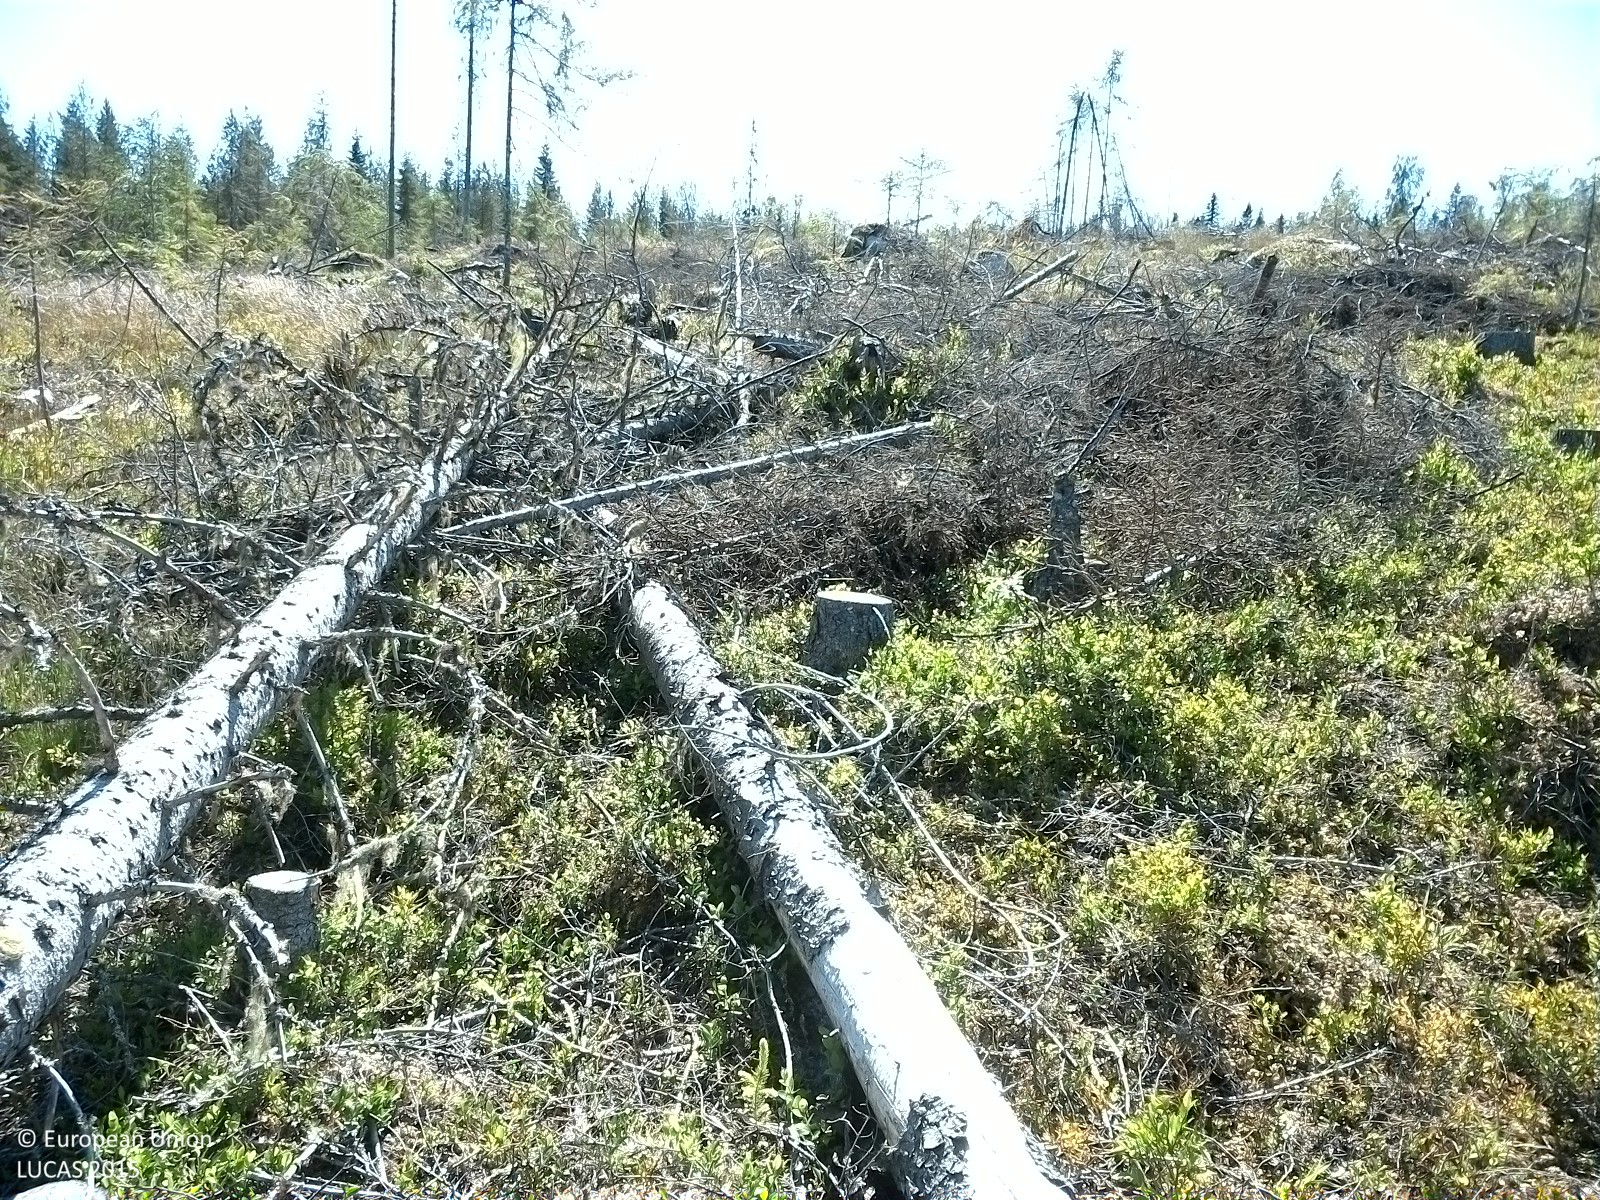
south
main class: Woodland
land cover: Spruce dominated mixed woodland
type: boreal forest
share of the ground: 10 - 25 %
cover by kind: herbaceous plants 30 %, unconsolidated bare surface 30 %, shrubs 20 %, coniferous forest trees 15 %, broadleaved forest trees 5 %
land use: Forestry
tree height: < 5 m
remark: Clear cut
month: July
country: SE
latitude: 62.2571
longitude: 16.8551
